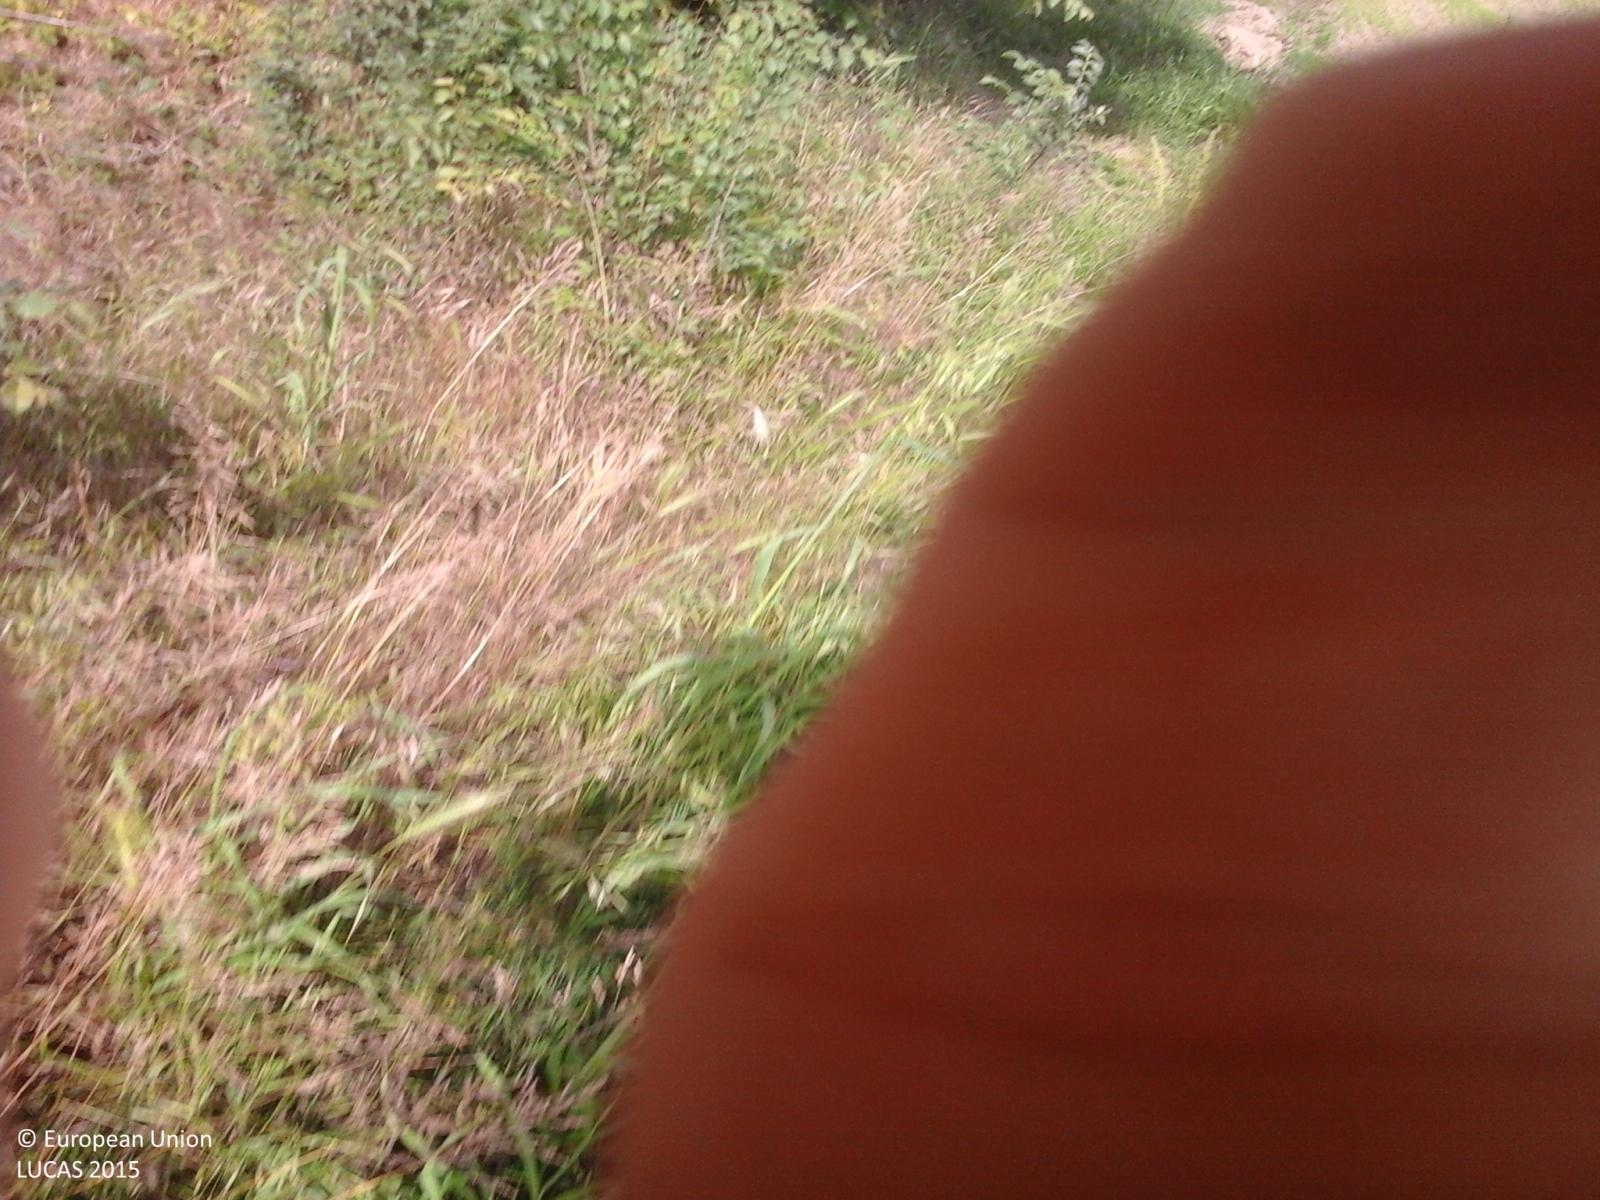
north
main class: Cropland
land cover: Rice
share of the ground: > 75 %
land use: Agriculture (excluding fallow land and kitchen gardens)
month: May
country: IT
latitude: 45.3029
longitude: 9.1725
